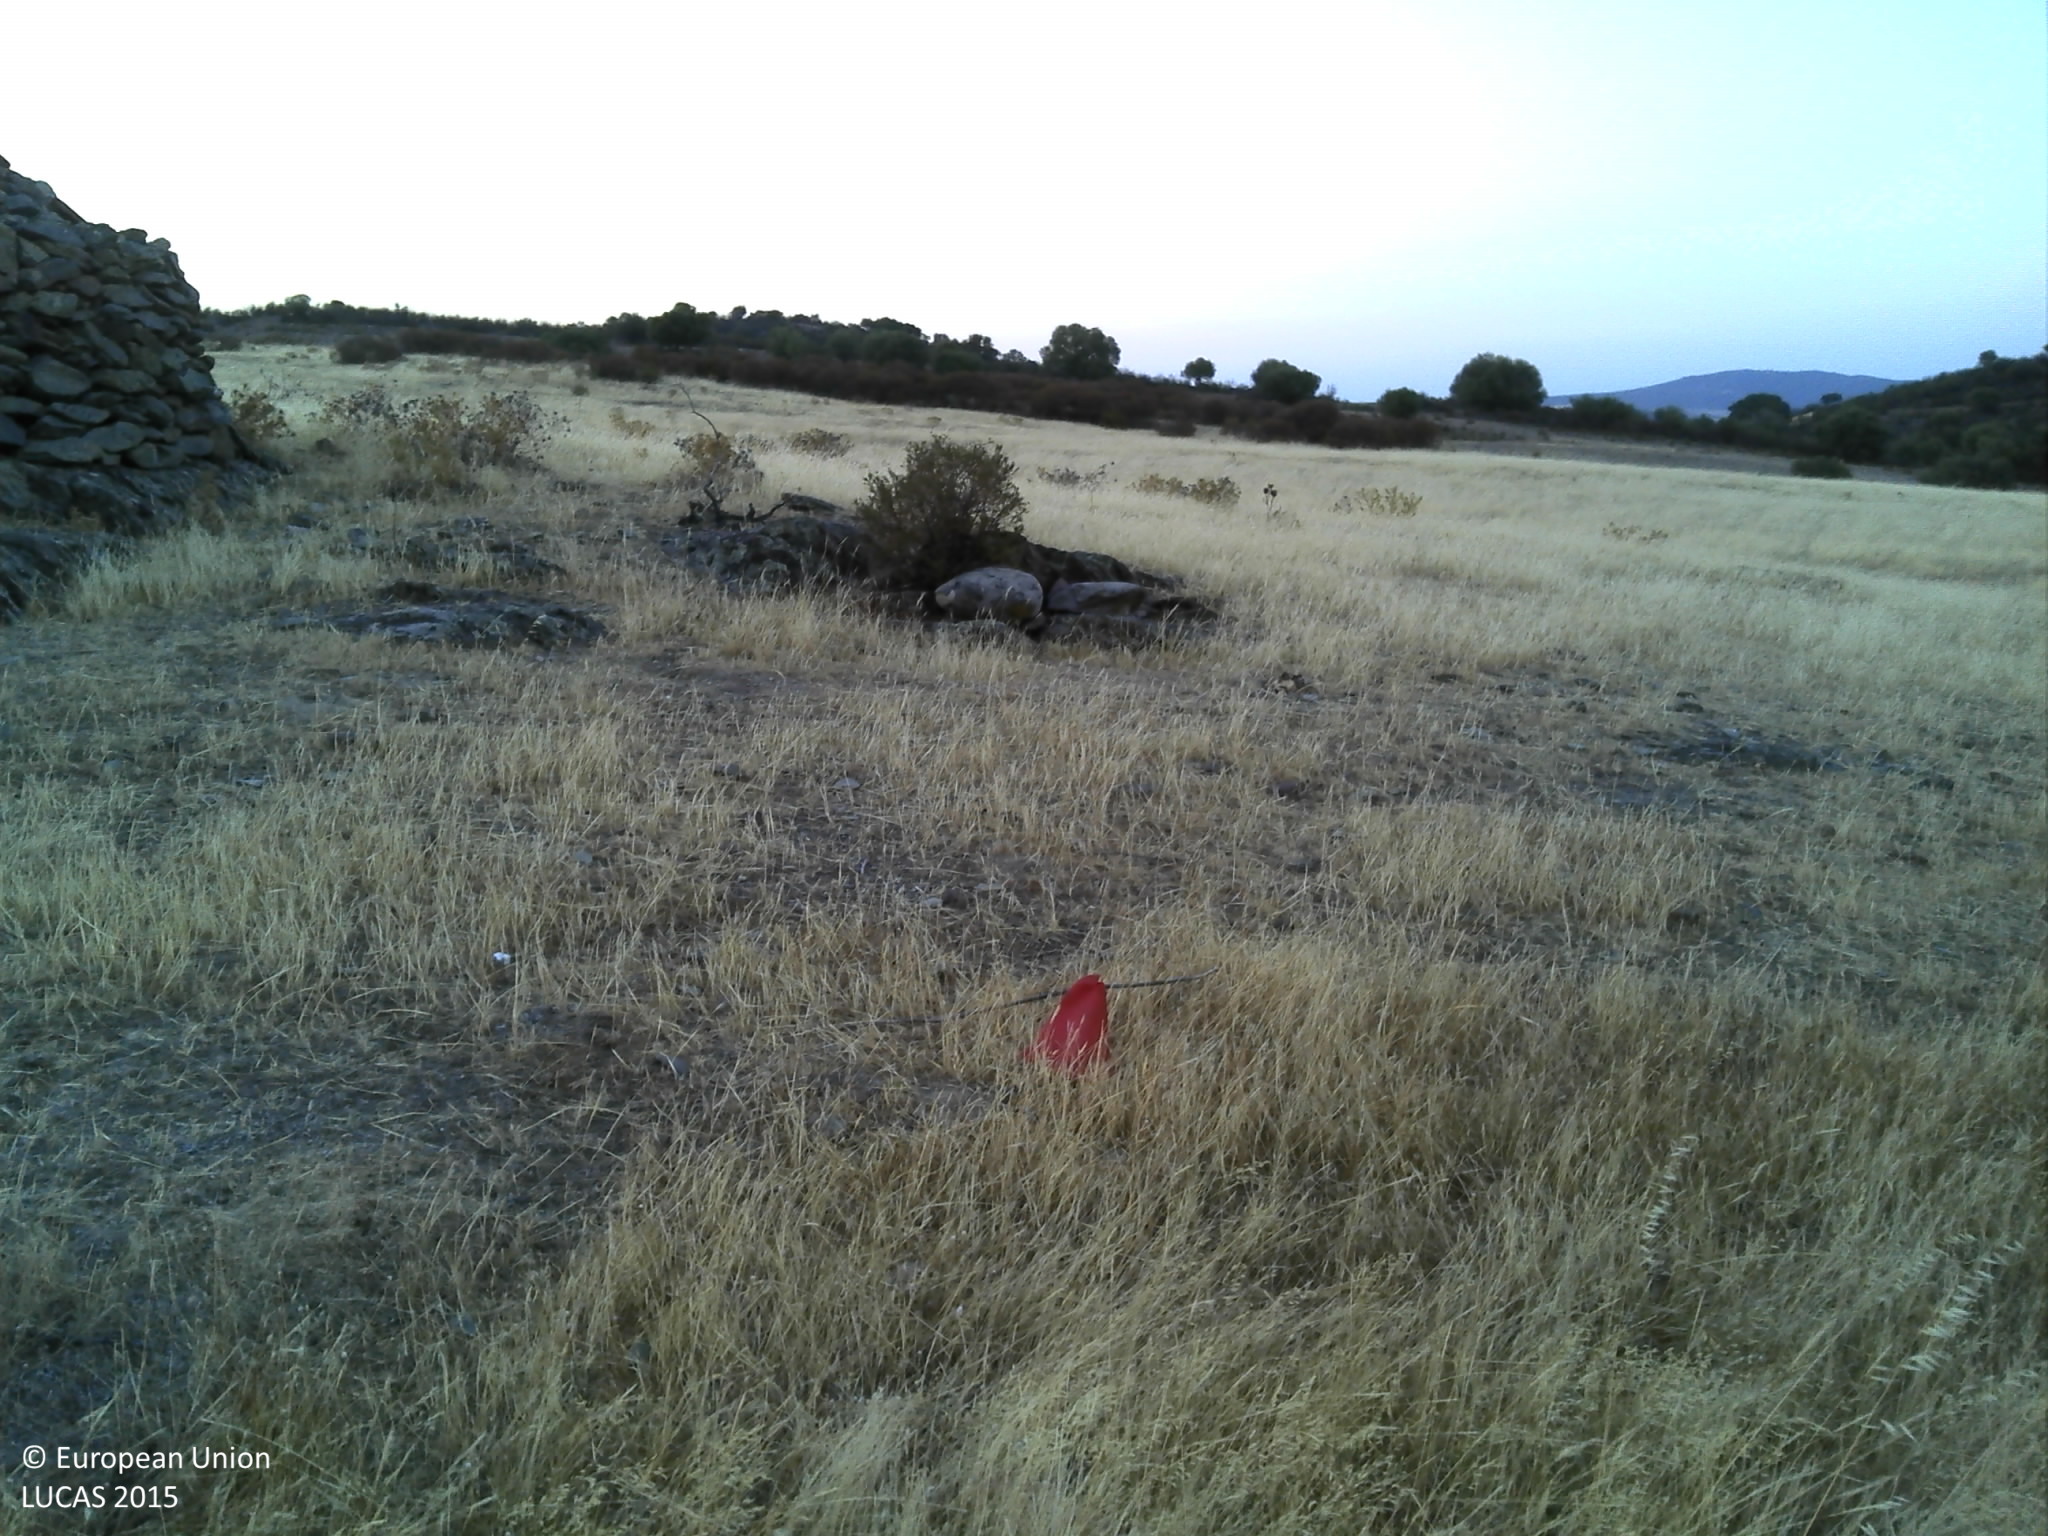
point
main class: Grassland
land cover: Grassland without tree/shrub cover
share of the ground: 50 - 75 %
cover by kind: herbaceous plants 65 %, unconsolidated bare surface 35 %
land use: Agriculture (excluding fallow land and kitchen gardens)
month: July
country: PT
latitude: 37.6012
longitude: -7.8358
